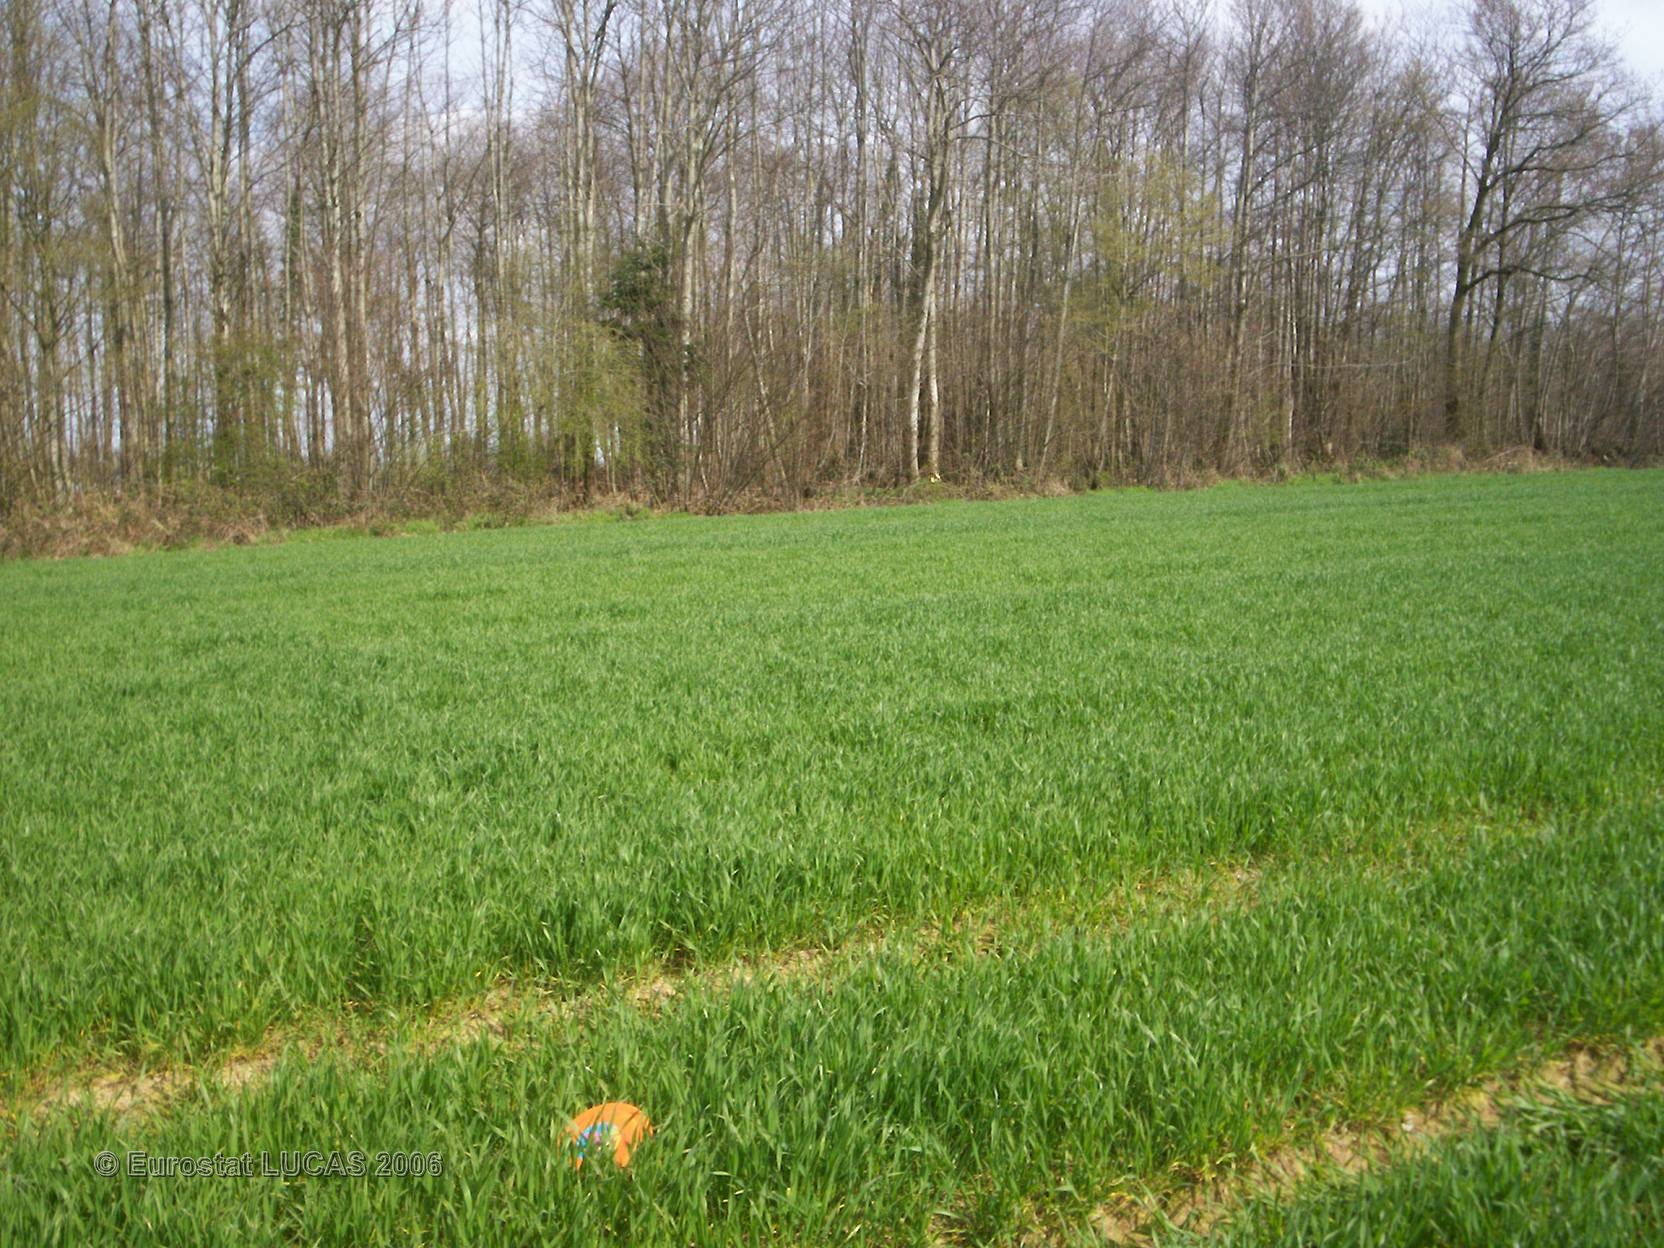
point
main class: Cropland
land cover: Common wheat
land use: Agriculture (excluding fallow land and kitchen gardens)
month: April
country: FR
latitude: 47.9568
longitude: -1.5760
